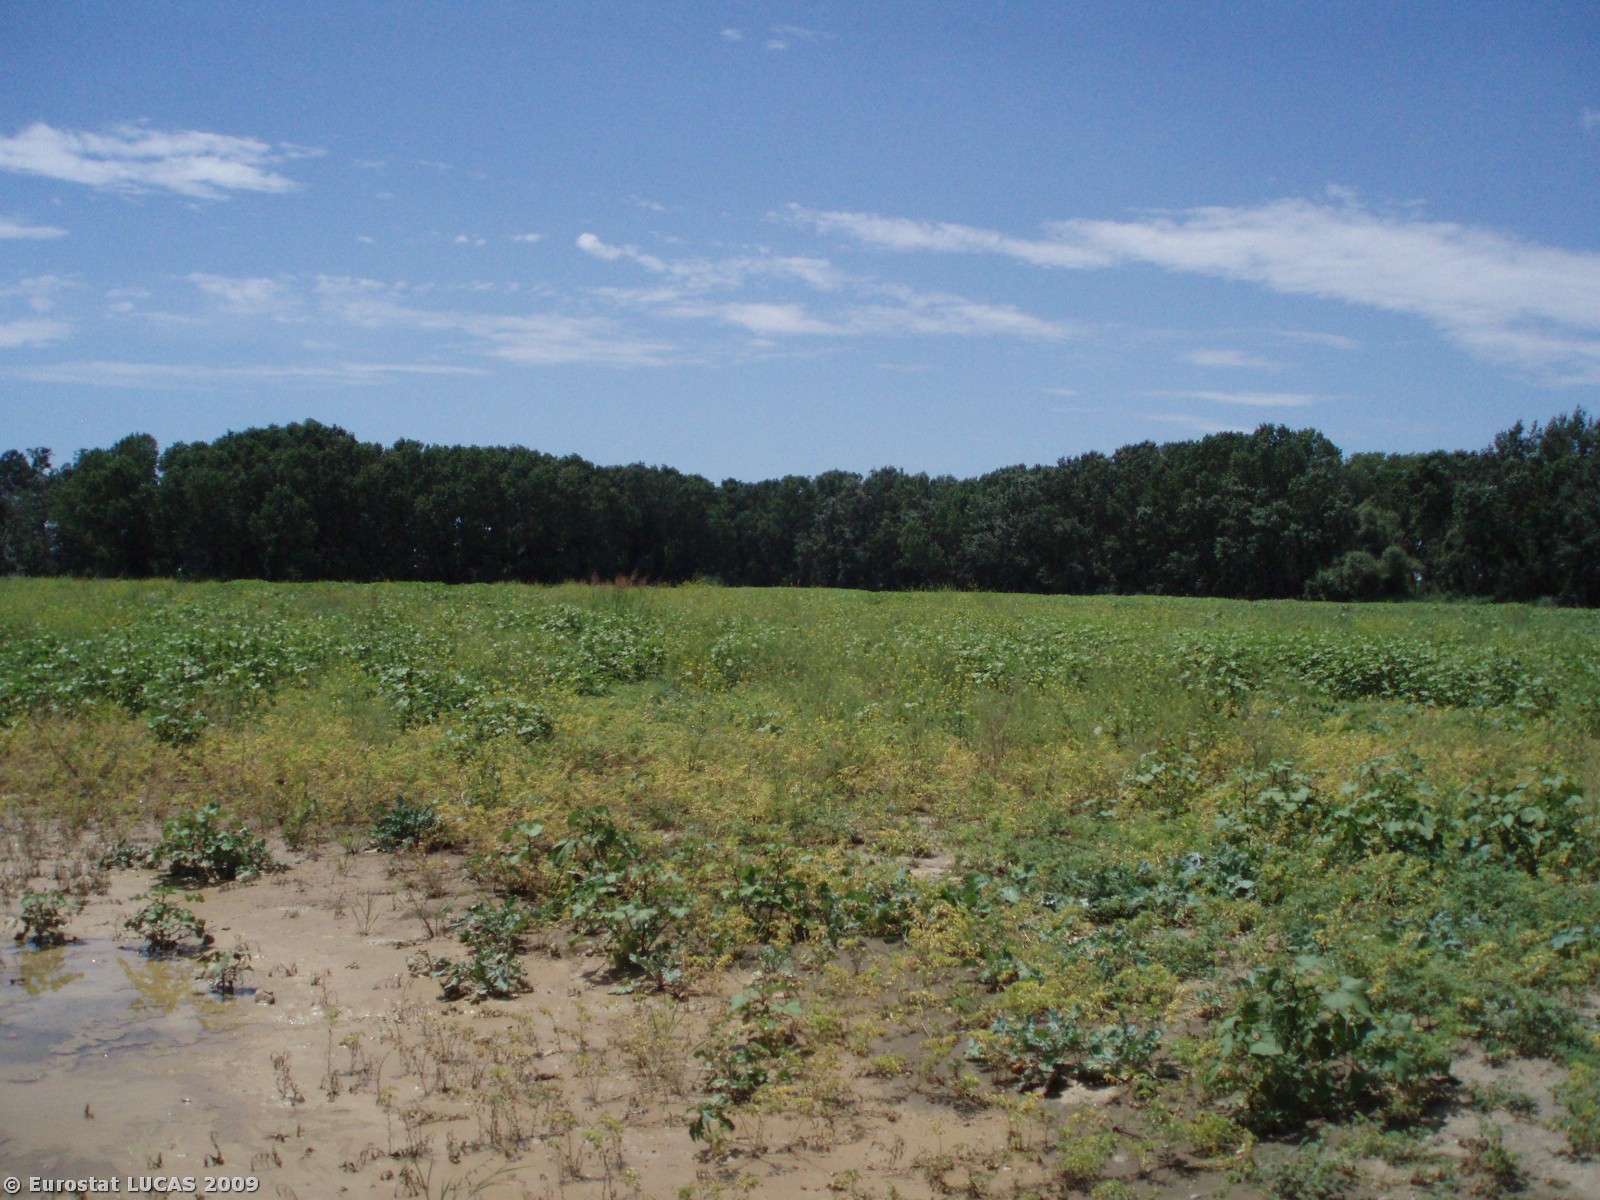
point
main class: Cropland
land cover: Sunflower
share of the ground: > 75 %
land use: Agriculture (excluding fallow land and kitchen gardens)
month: June
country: IT
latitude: 42.3526
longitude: 11.5848
